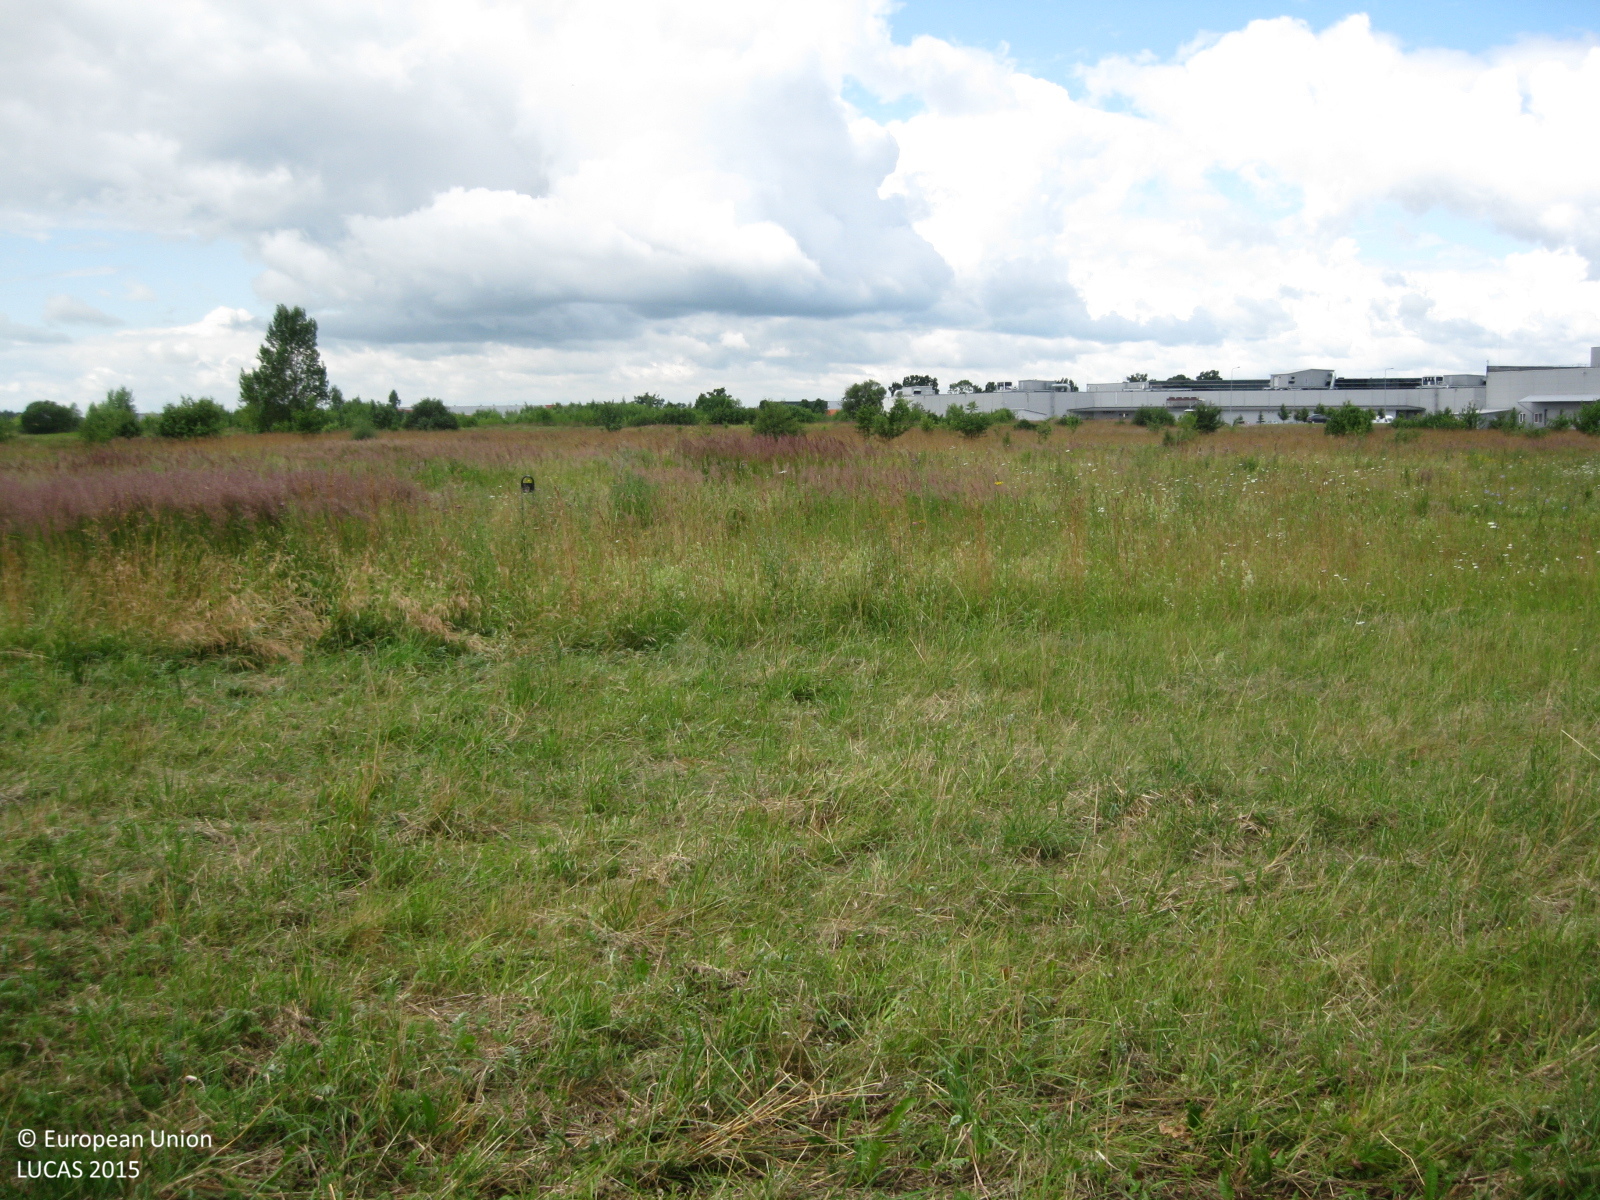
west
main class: Grassland
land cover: Grassland with sparse tree/shrub cover
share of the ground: > 75 %
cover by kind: herbaceous plants 90 %, broadleaved forest trees 5 %, shrubs 5 %
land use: Amenities, museums, leisure
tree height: > 5 m
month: July
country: LT
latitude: 55.7270
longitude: 24.3139
